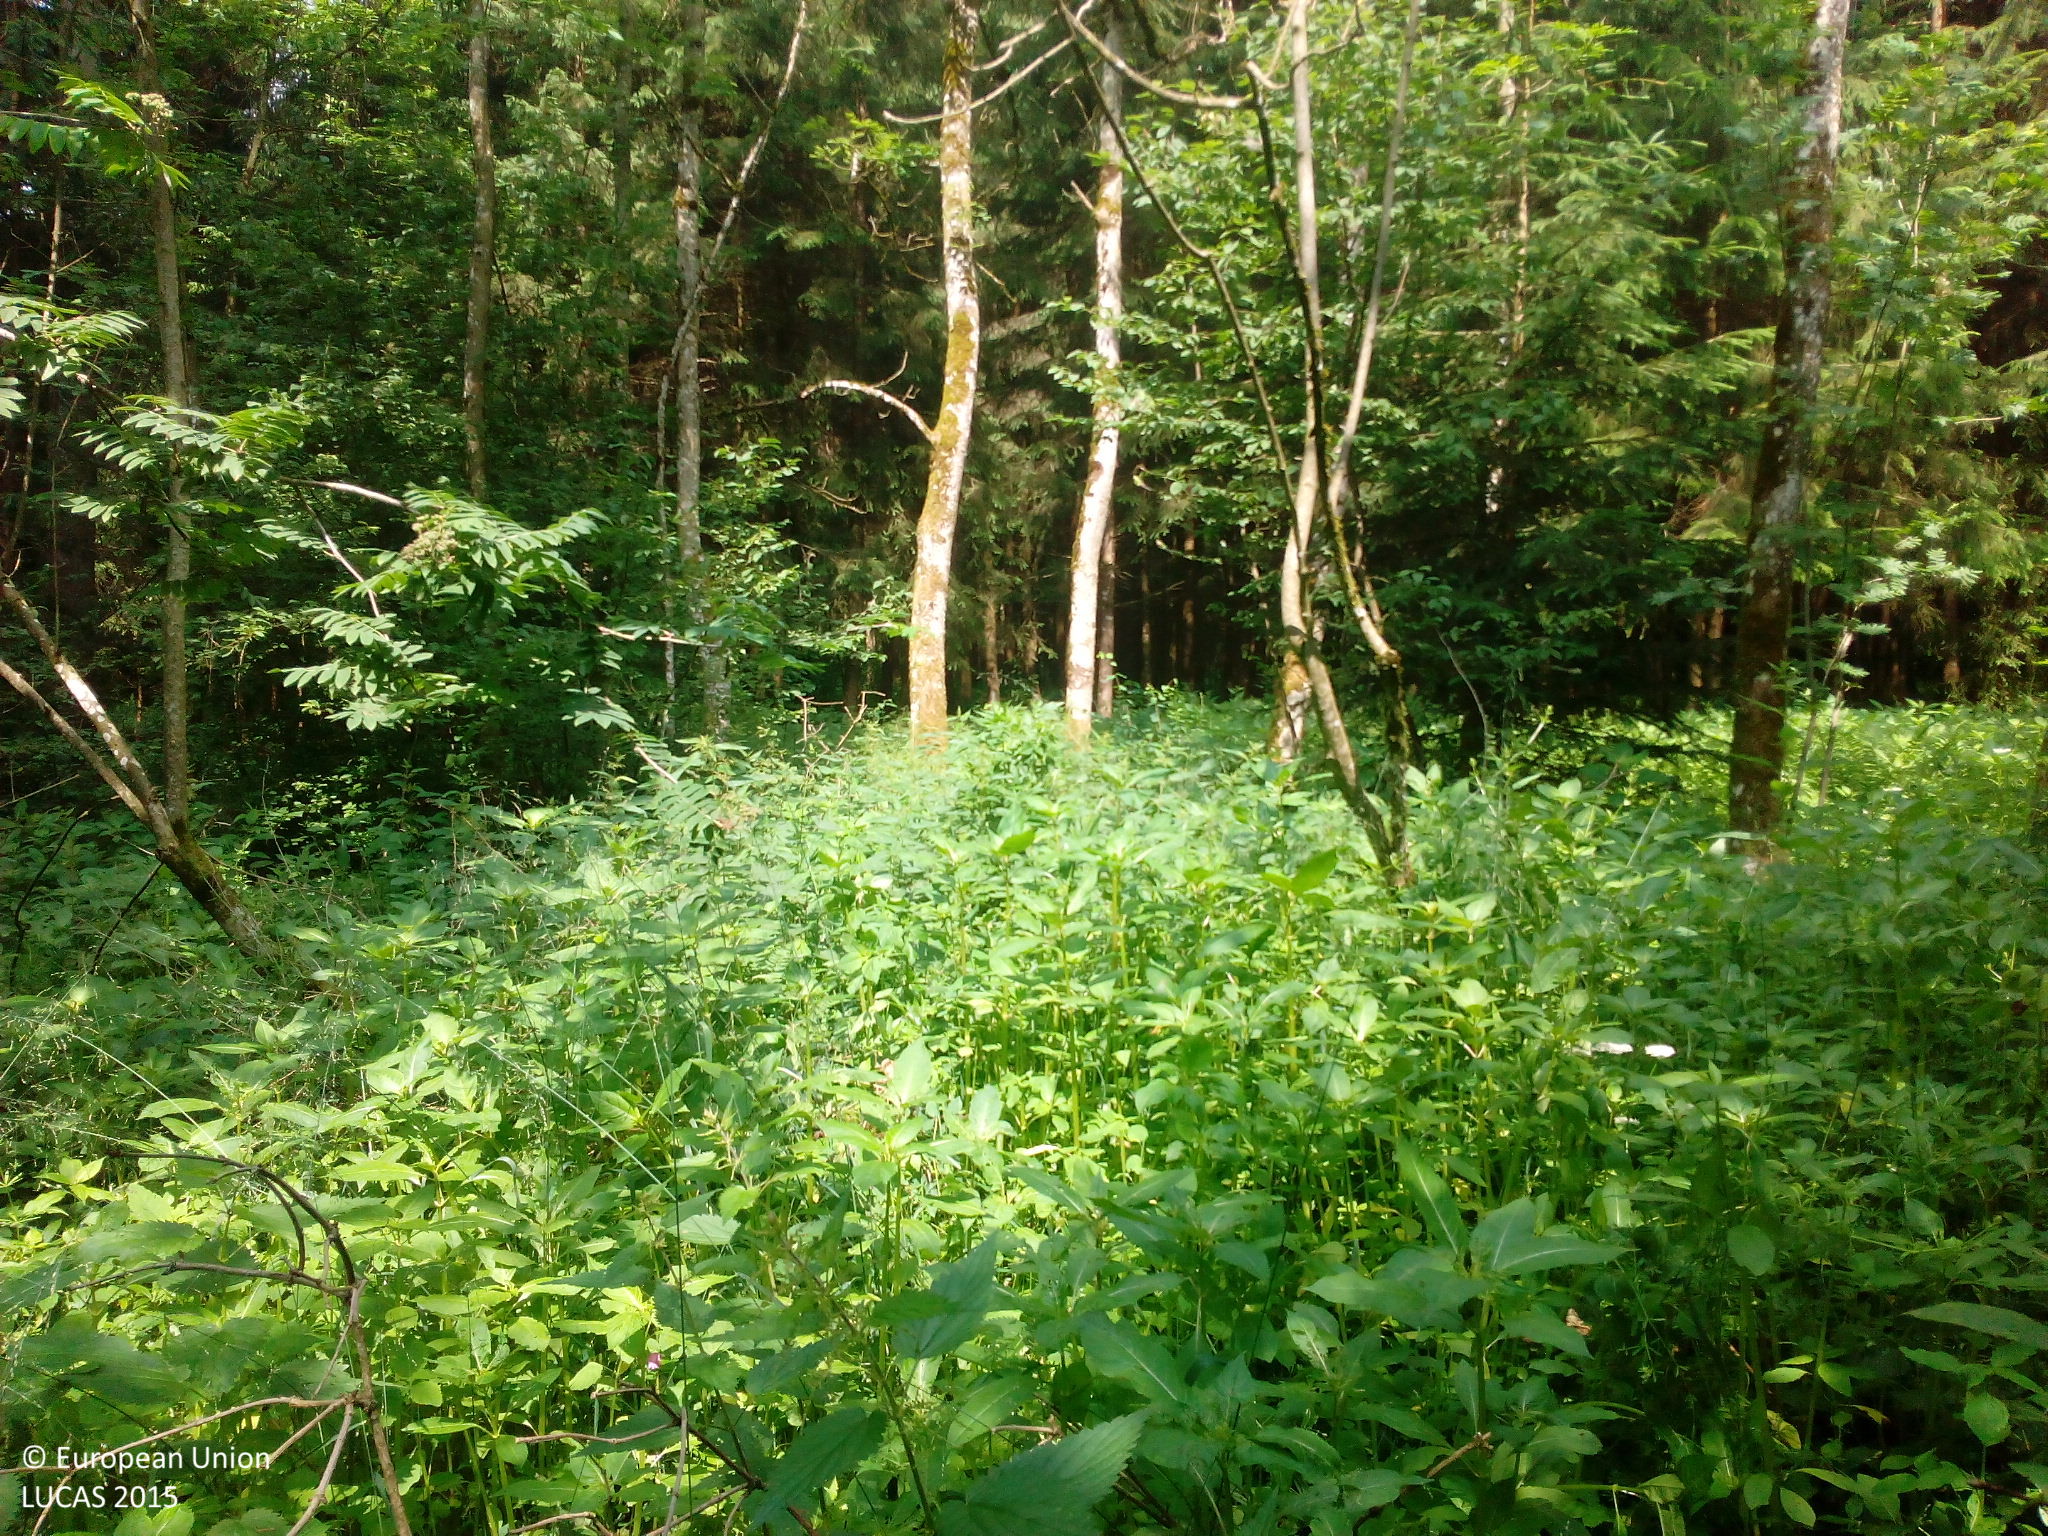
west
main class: Woodland
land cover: Other mixed woodland
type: hemiboreal forest and nemoral coniferous forest and mixed broadleaved-coniferous forest
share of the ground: > 75 %
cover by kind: broadleaved forest trees 55 %, coniferous forest trees 25 %, shrubs 10 %, herbaceous plants 10 %
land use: Forestry
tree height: > 5 m
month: June
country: DE
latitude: 47.7196
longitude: 9.9334
